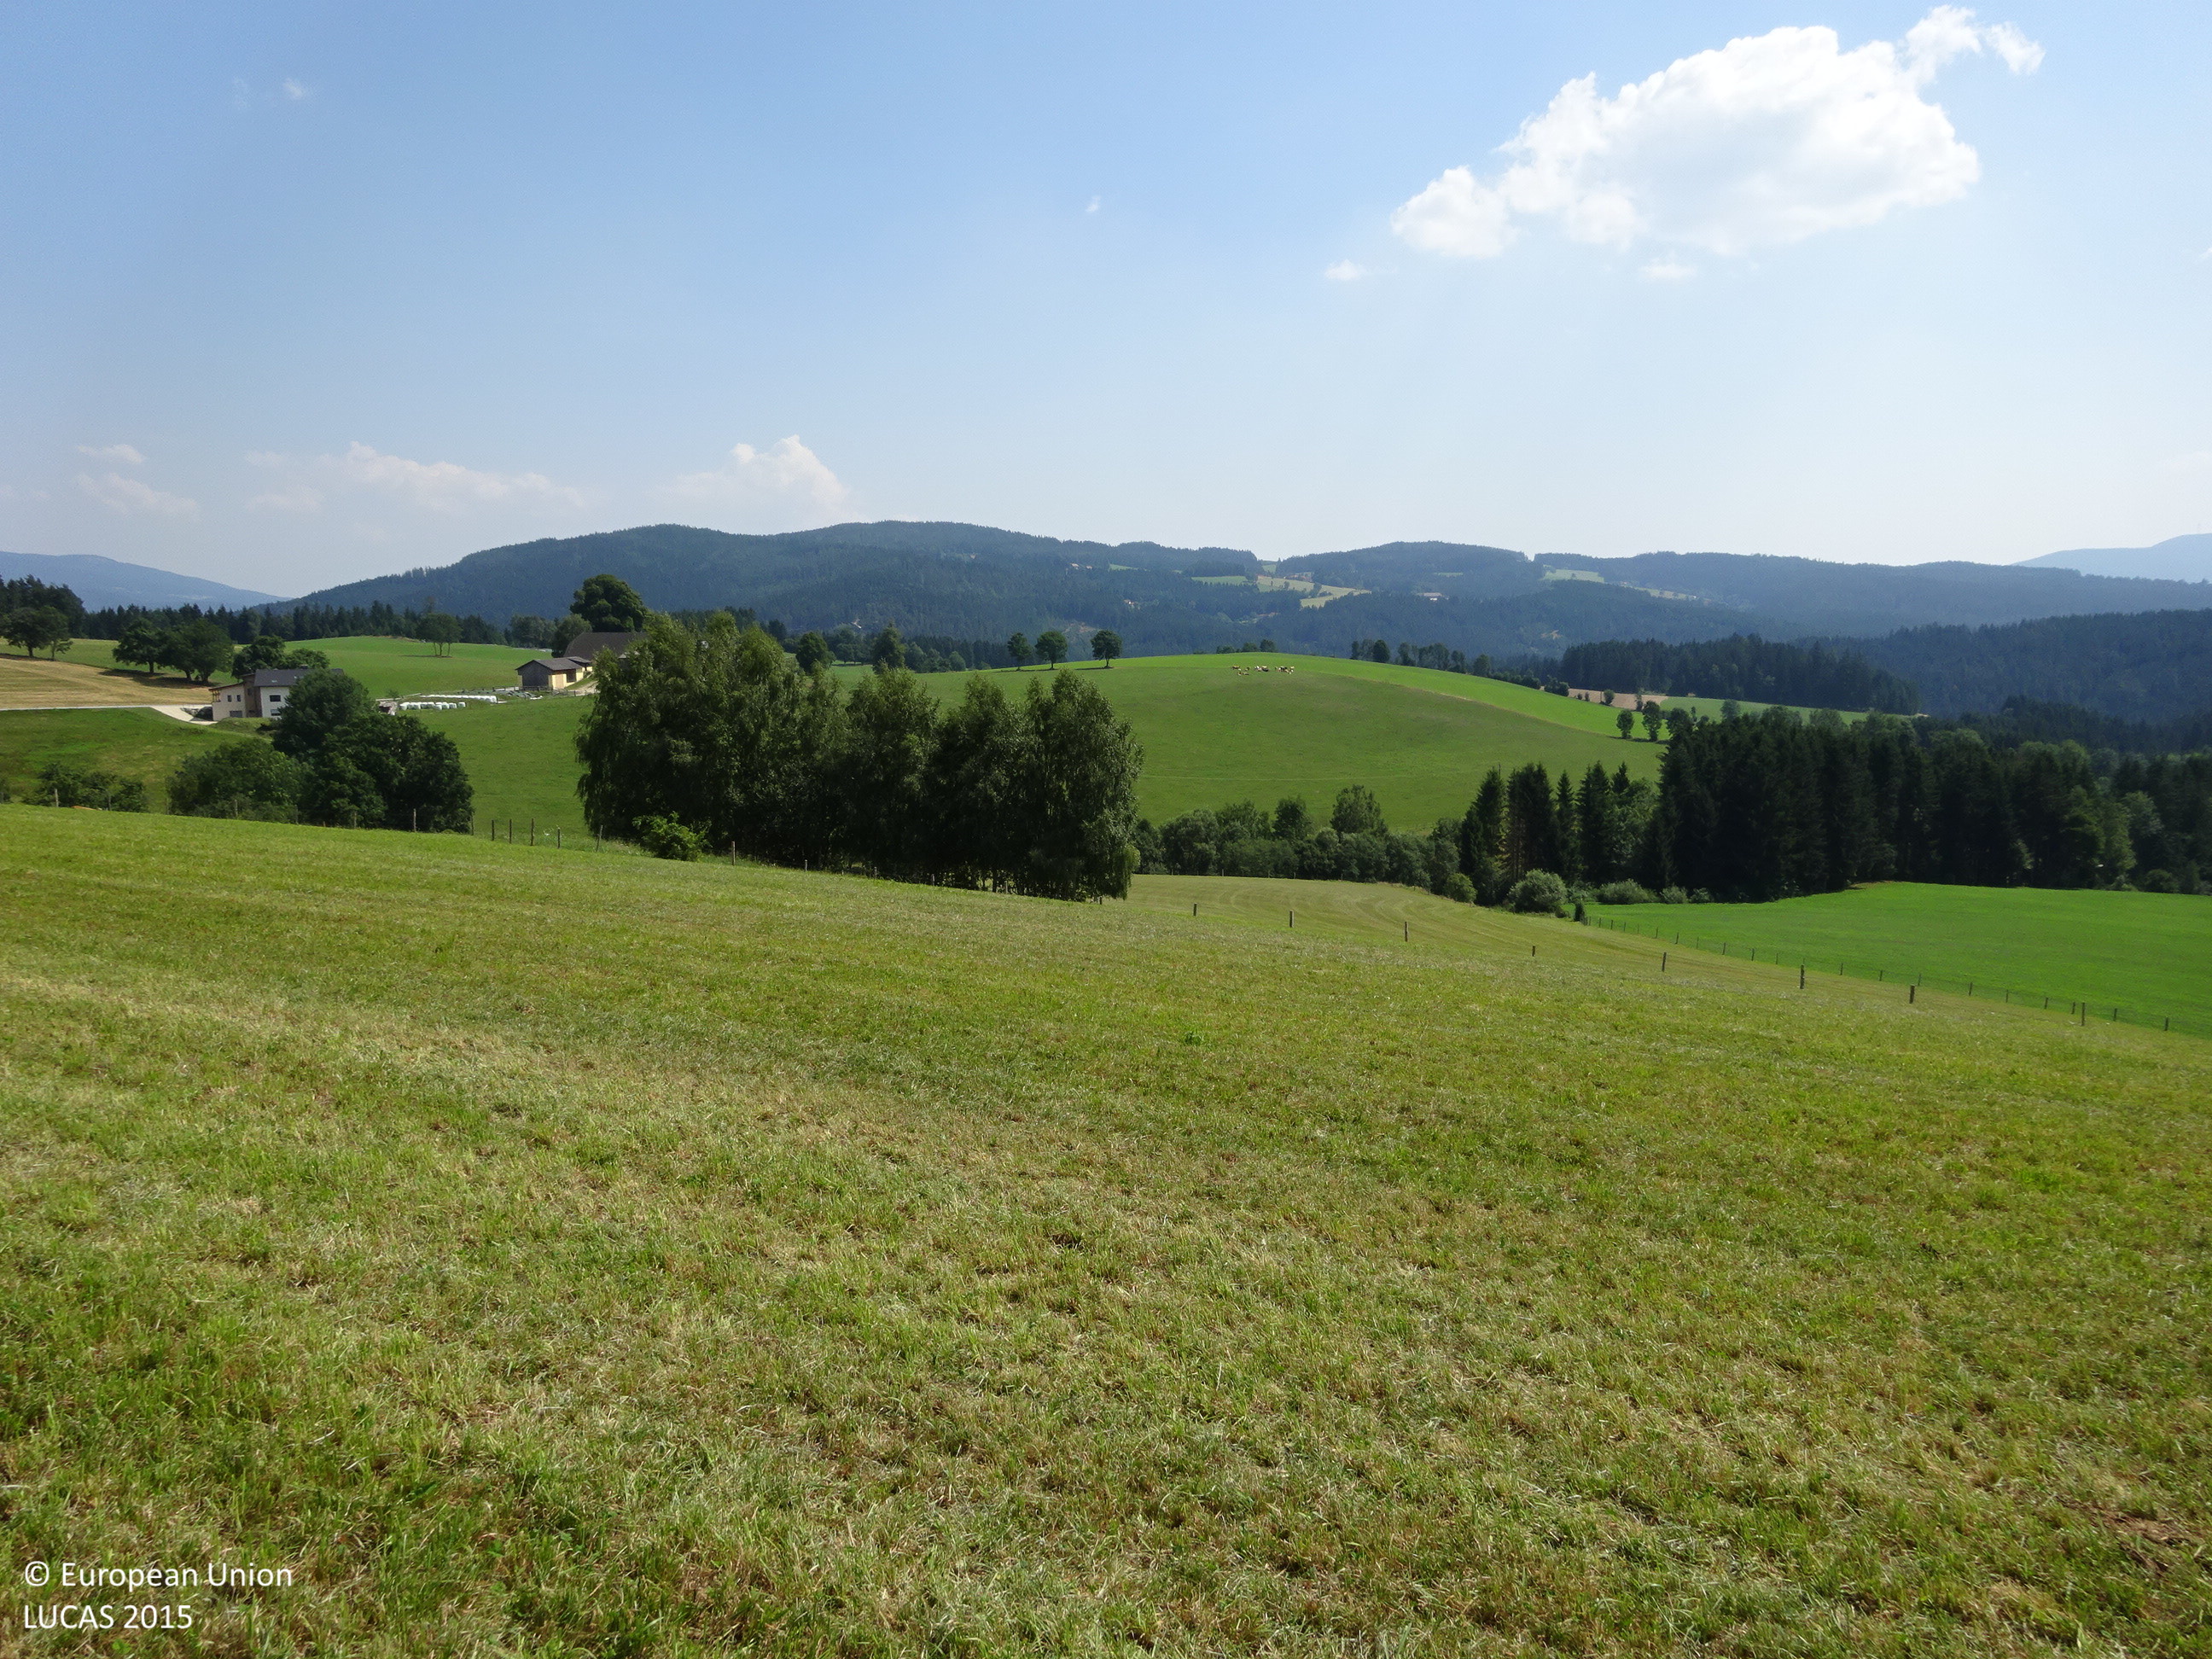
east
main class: Grassland
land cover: Grassland without tree/shrub cover
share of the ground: > 75 %
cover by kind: herbaceous plants 100 %
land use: Agriculture (excluding fallow land and kitchen gardens)
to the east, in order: Grassland without tree/shrub cover; Fences; Grassland without tree/shrub cover; Fences; Grass margins; Paved roads, cycling and walking lanes; Fences; Grassland without tree/shrub cover; Fences; Grassland without tree/shrub cover; Fences; Grassland without tree/shrub cover
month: August
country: AT
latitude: 47.4396
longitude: 15.7961
